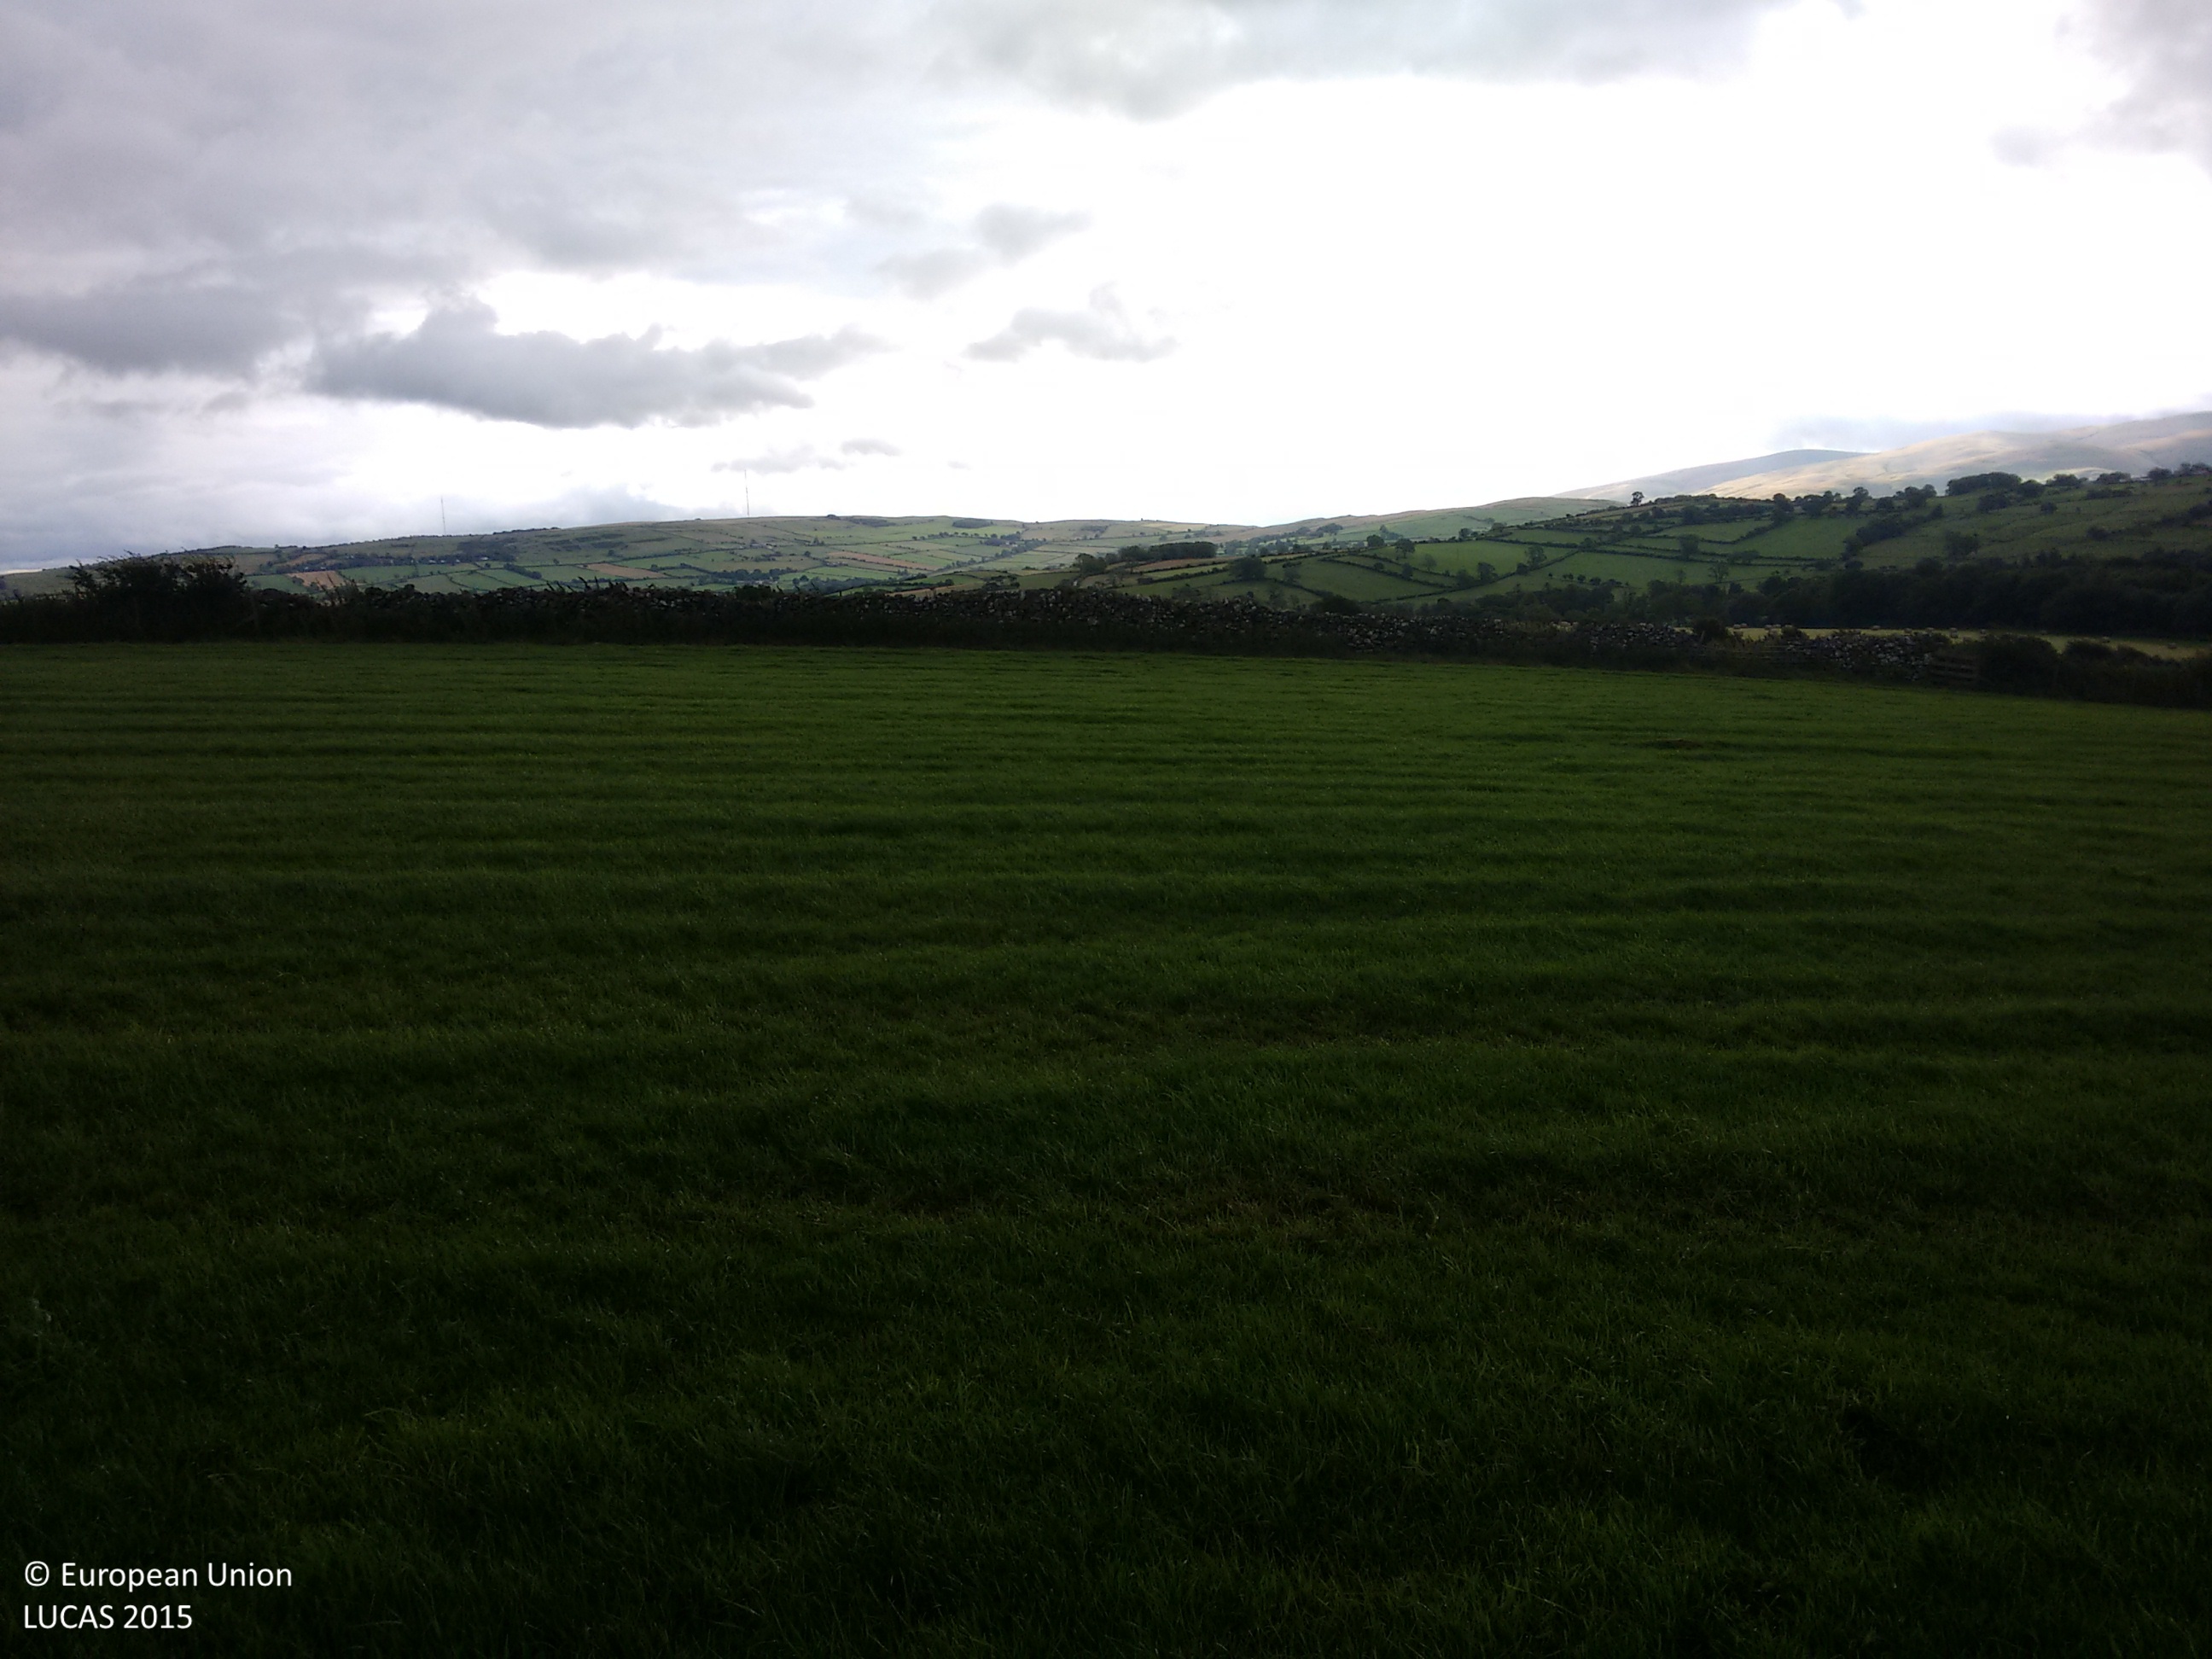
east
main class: Grassland
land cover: Grassland without tree/shrub cover
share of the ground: > 75 %
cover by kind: herbaceous plants 100 %
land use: Agriculture (excluding fallow land and kitchen gardens)
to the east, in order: Grassland without tree/shrub cover; Fences; Dry stone walls; Fences; Grassland without tree/shrub cover; Fences; Managed hedges; Fences; Grassland without tree/shrub cover; Fences; Managed hedges; Grassland without tree/shrub cover
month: August
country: GB
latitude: 54.7325
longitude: -3.2299
